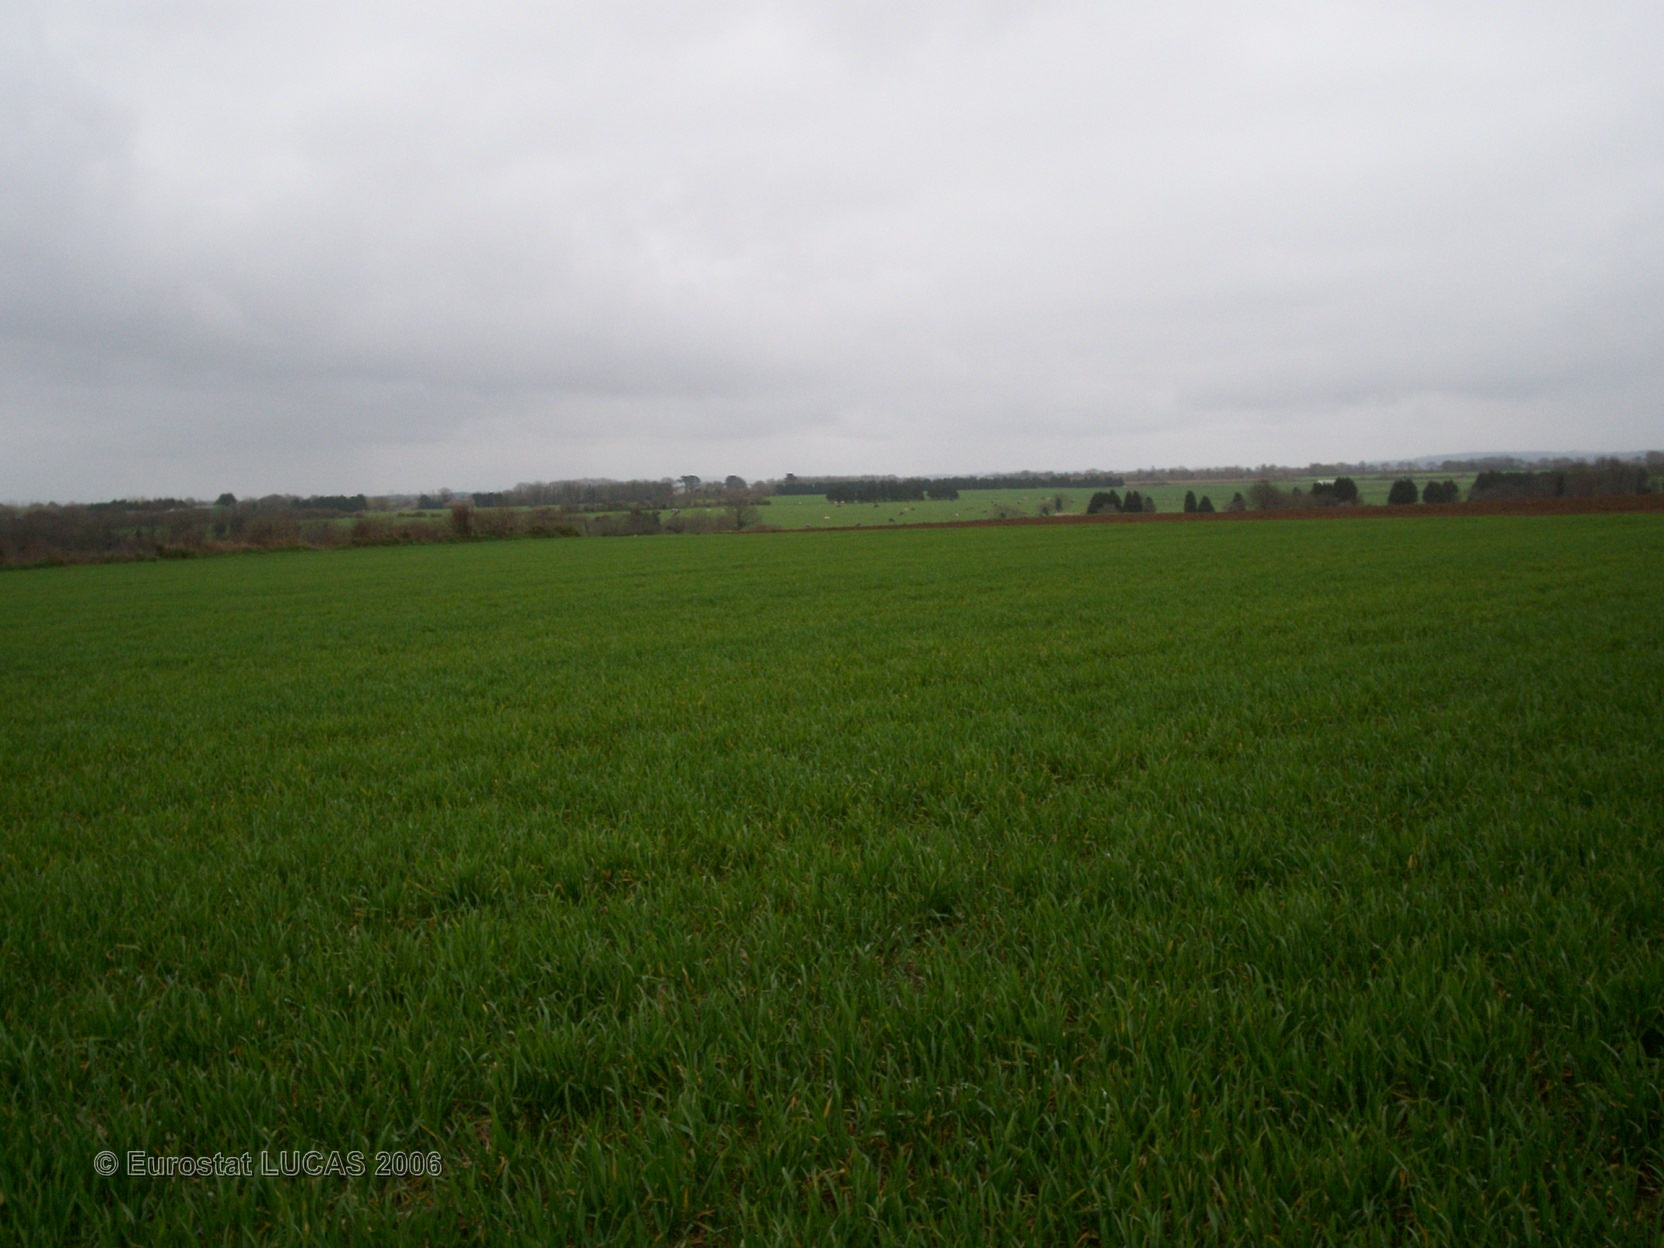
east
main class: Cropland
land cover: Common wheat
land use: Agriculture (excluding fallow land and kitchen gardens)
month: April
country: FR
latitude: 48.5371
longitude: -3.9428
